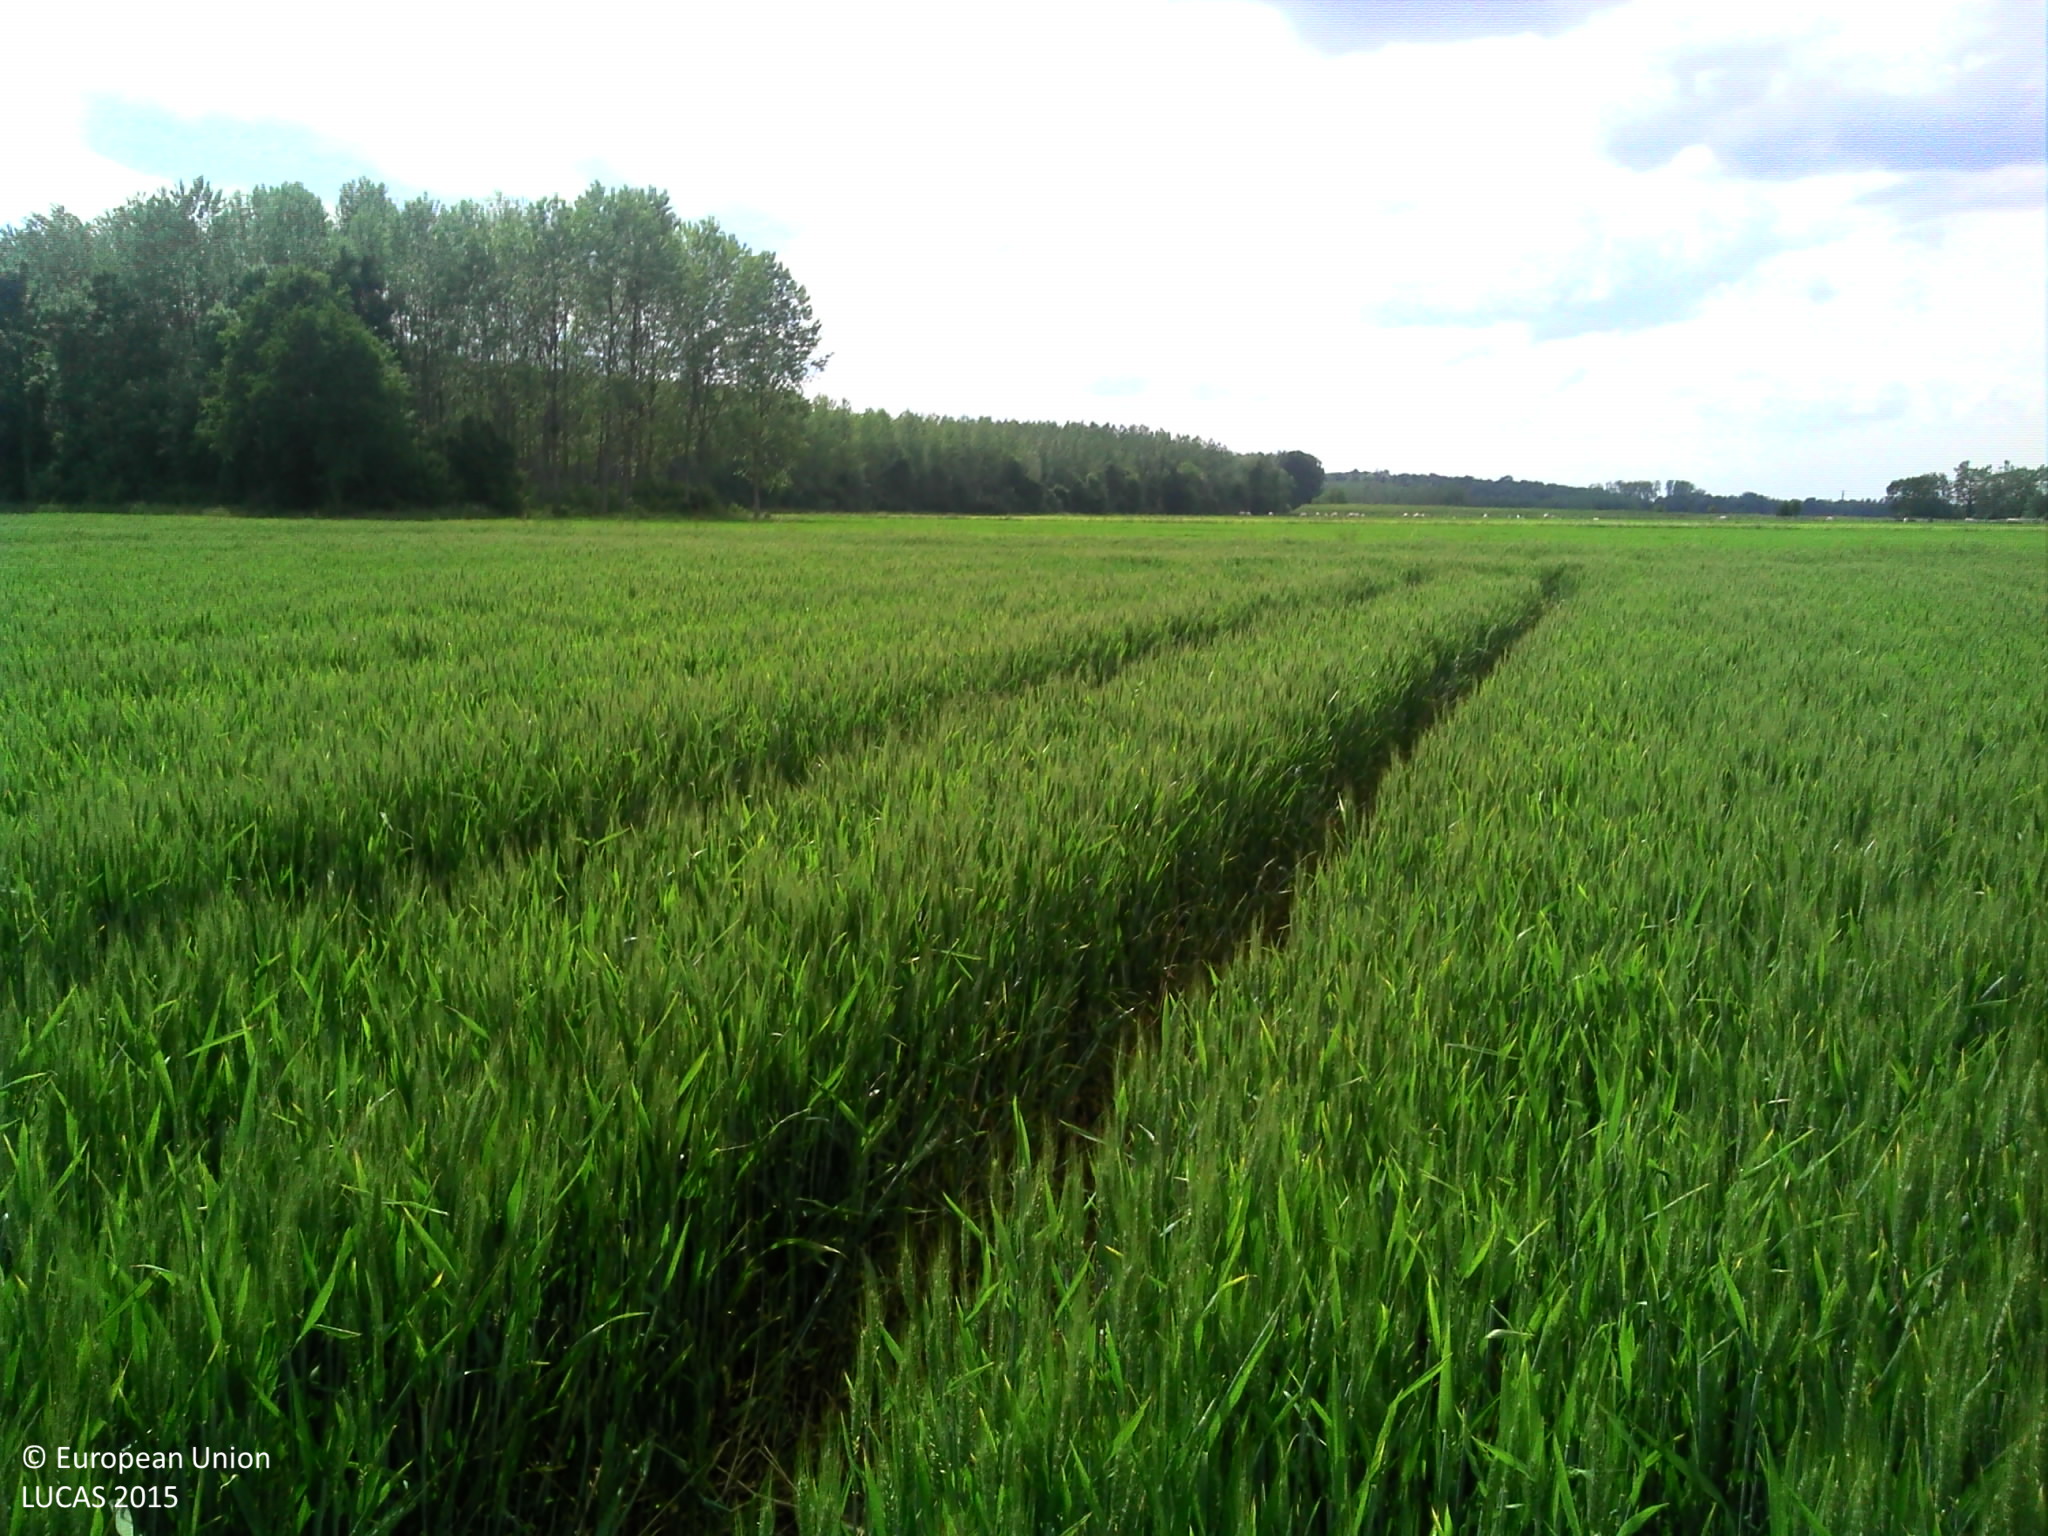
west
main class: Cropland
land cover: Common wheat
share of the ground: > 75 %
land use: Agriculture (excluding fallow land and kitchen gardens)
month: May
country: FR
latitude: 48.5892
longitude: 4.8325
